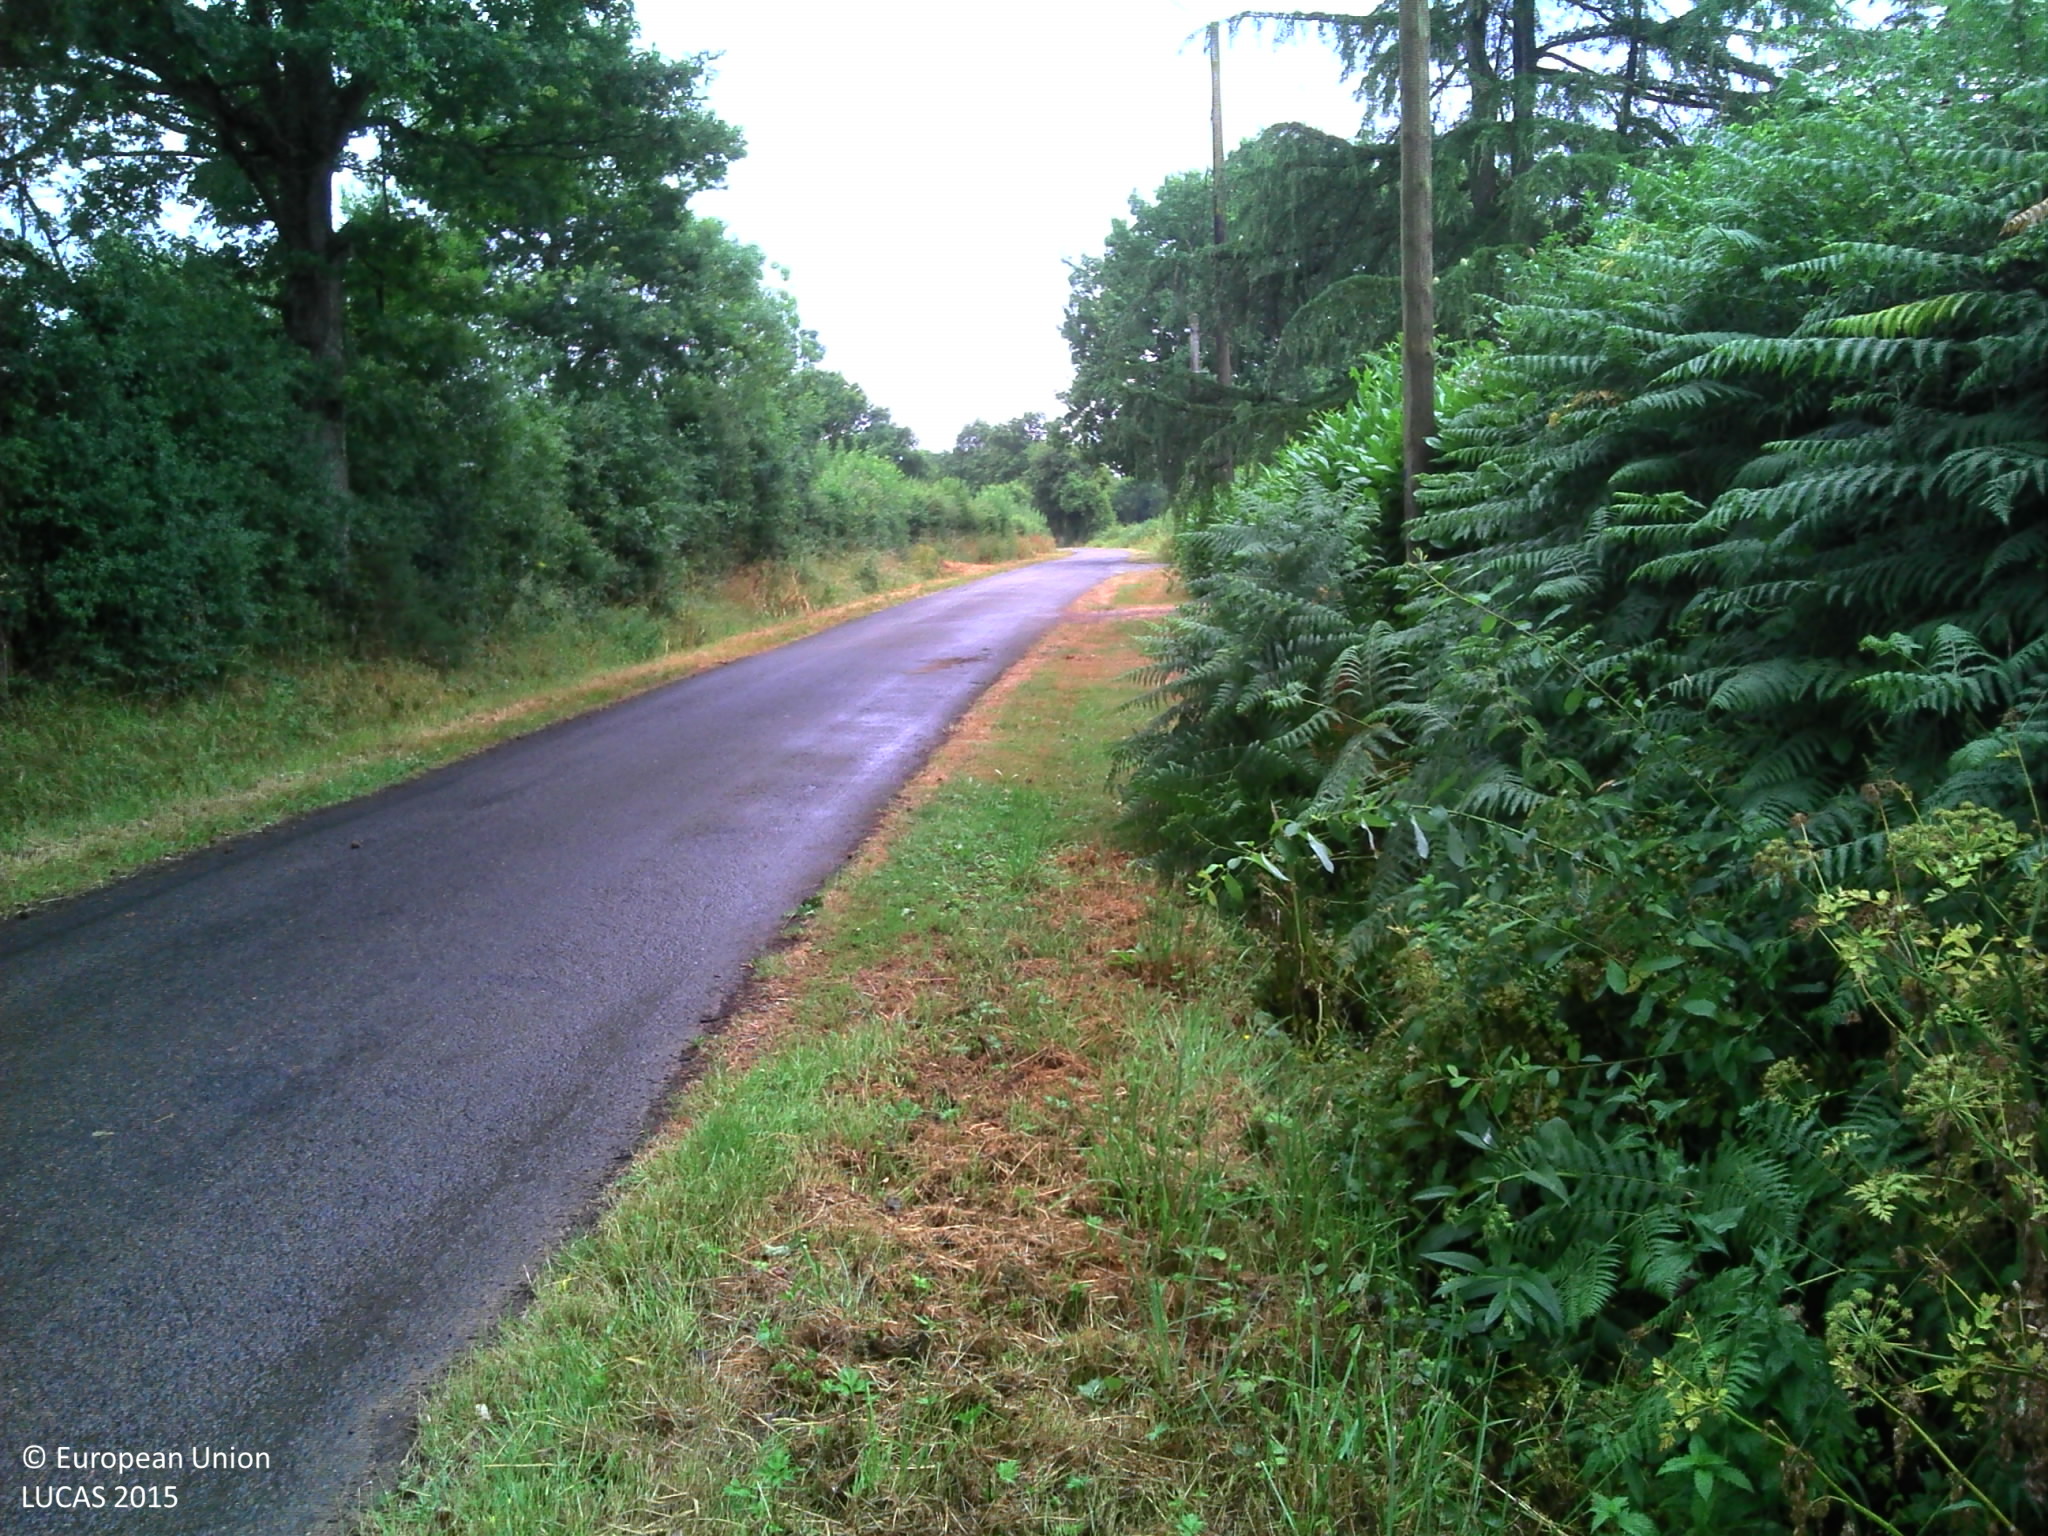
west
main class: Grassland
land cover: Grassland without tree/shrub cover
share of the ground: > 75 %
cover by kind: herbaceous plants 100 %
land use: Agriculture (excluding fallow land and kitchen gardens)
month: July
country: FR
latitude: 47.1896
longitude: -1.7778
